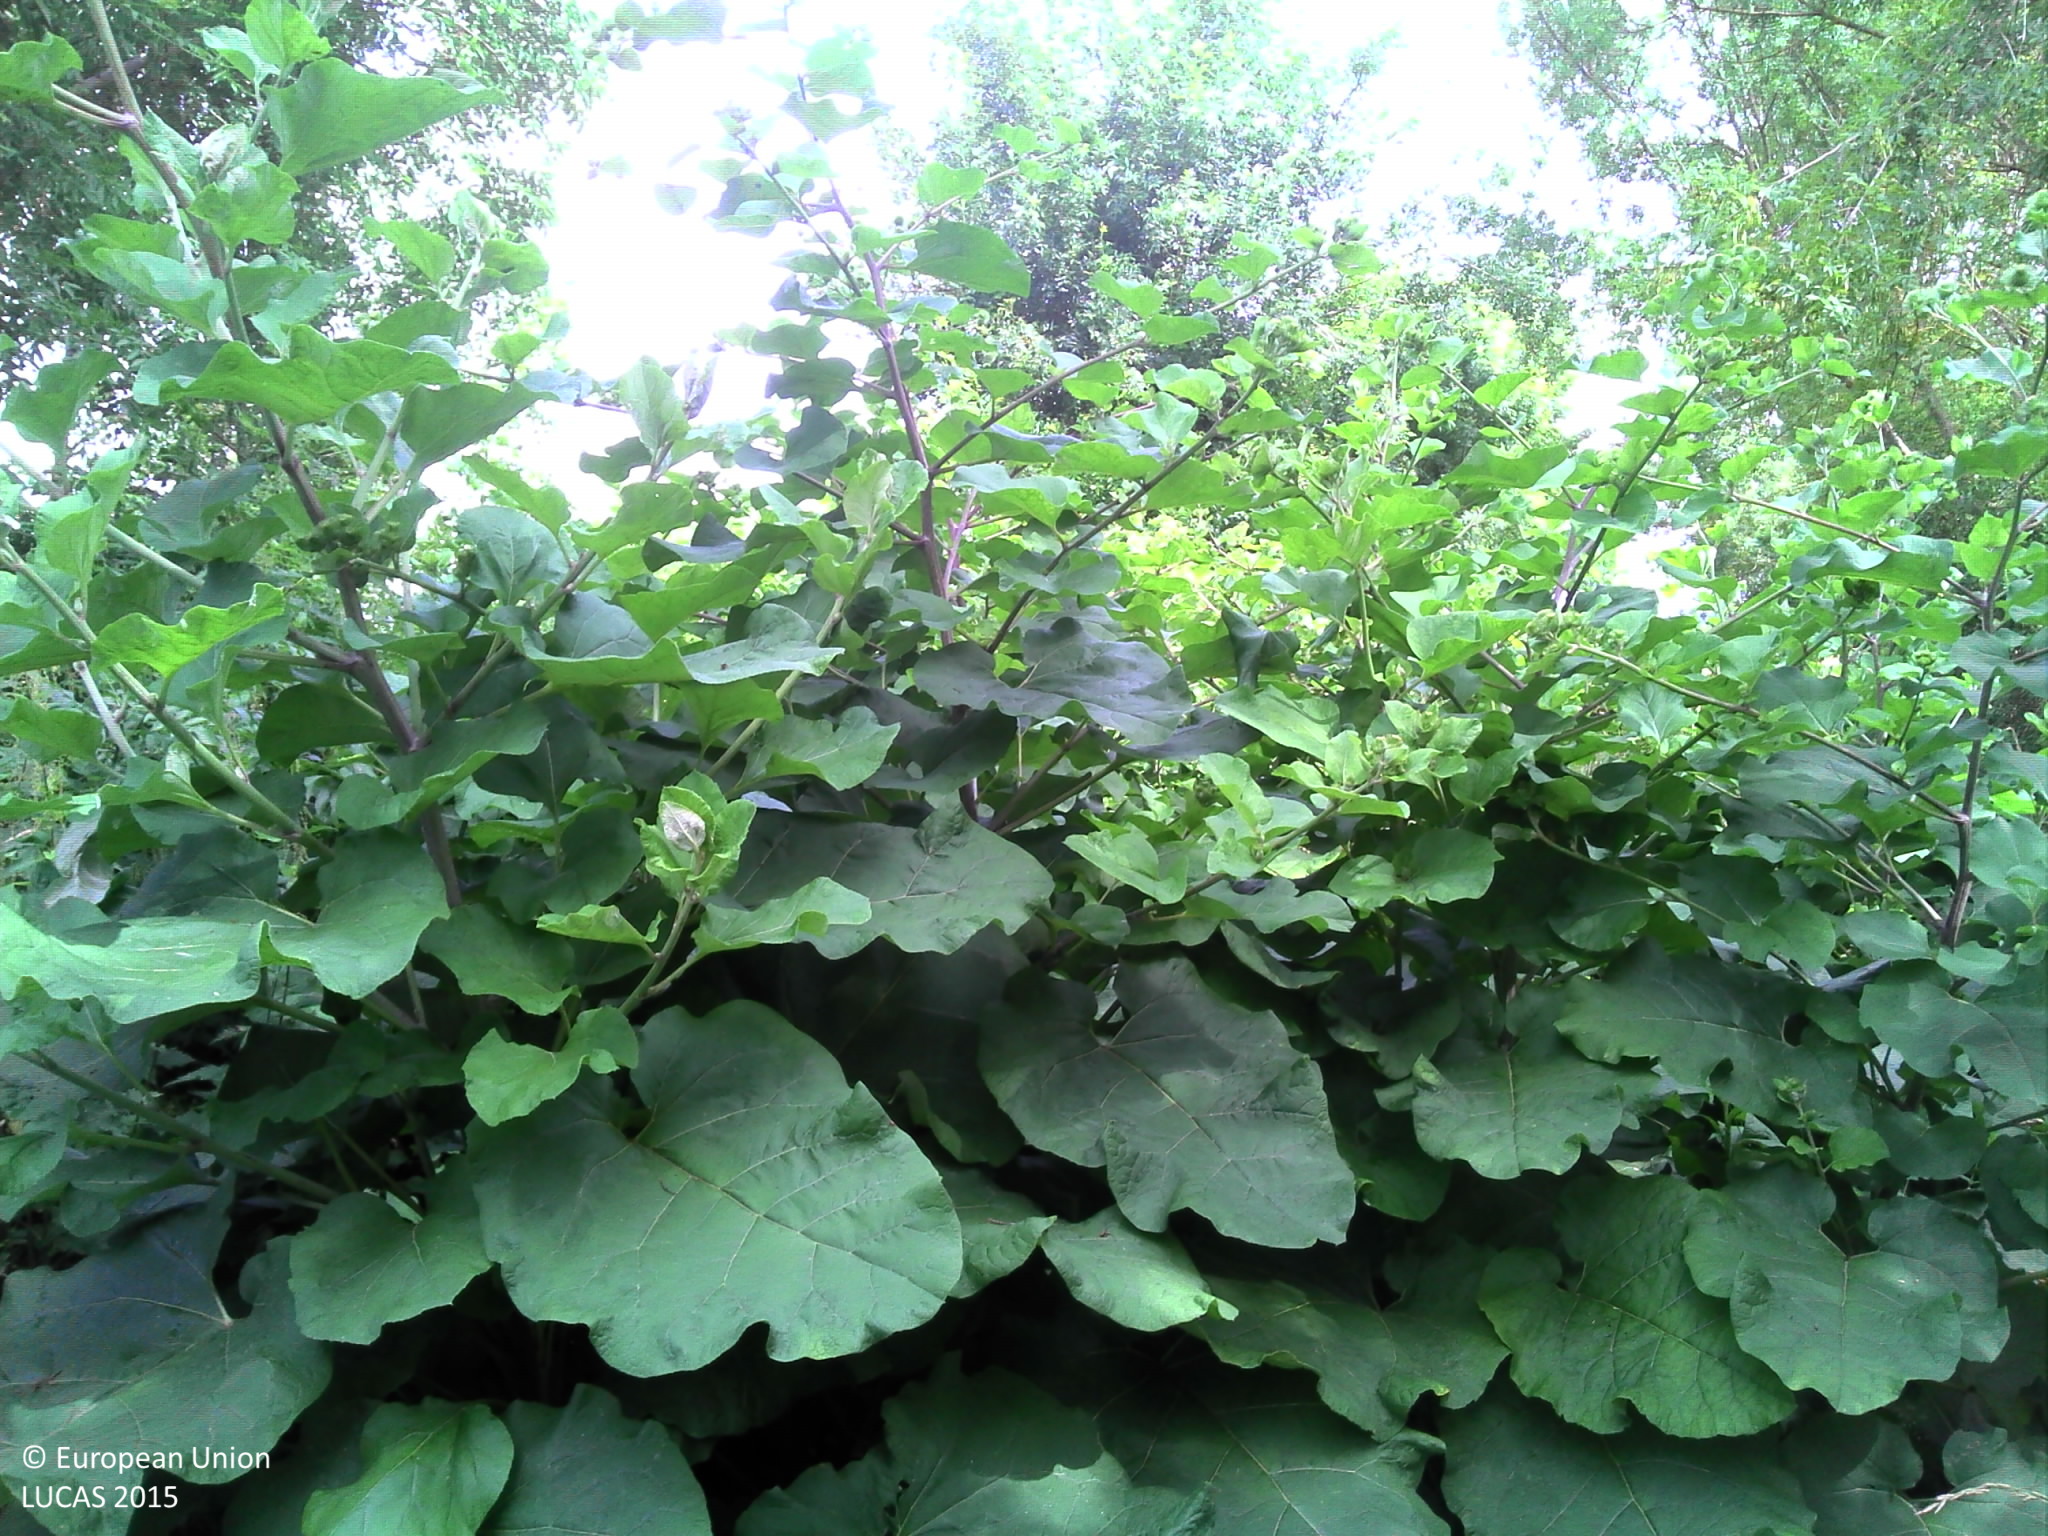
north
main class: Grassland
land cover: Grassland without tree/shrub cover
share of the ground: > 75 %
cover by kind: herbaceous plants 100 %
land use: Agriculture (excluding fallow land and kitchen gardens)
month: June
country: FR
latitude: 47.2646
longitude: 0.0499
